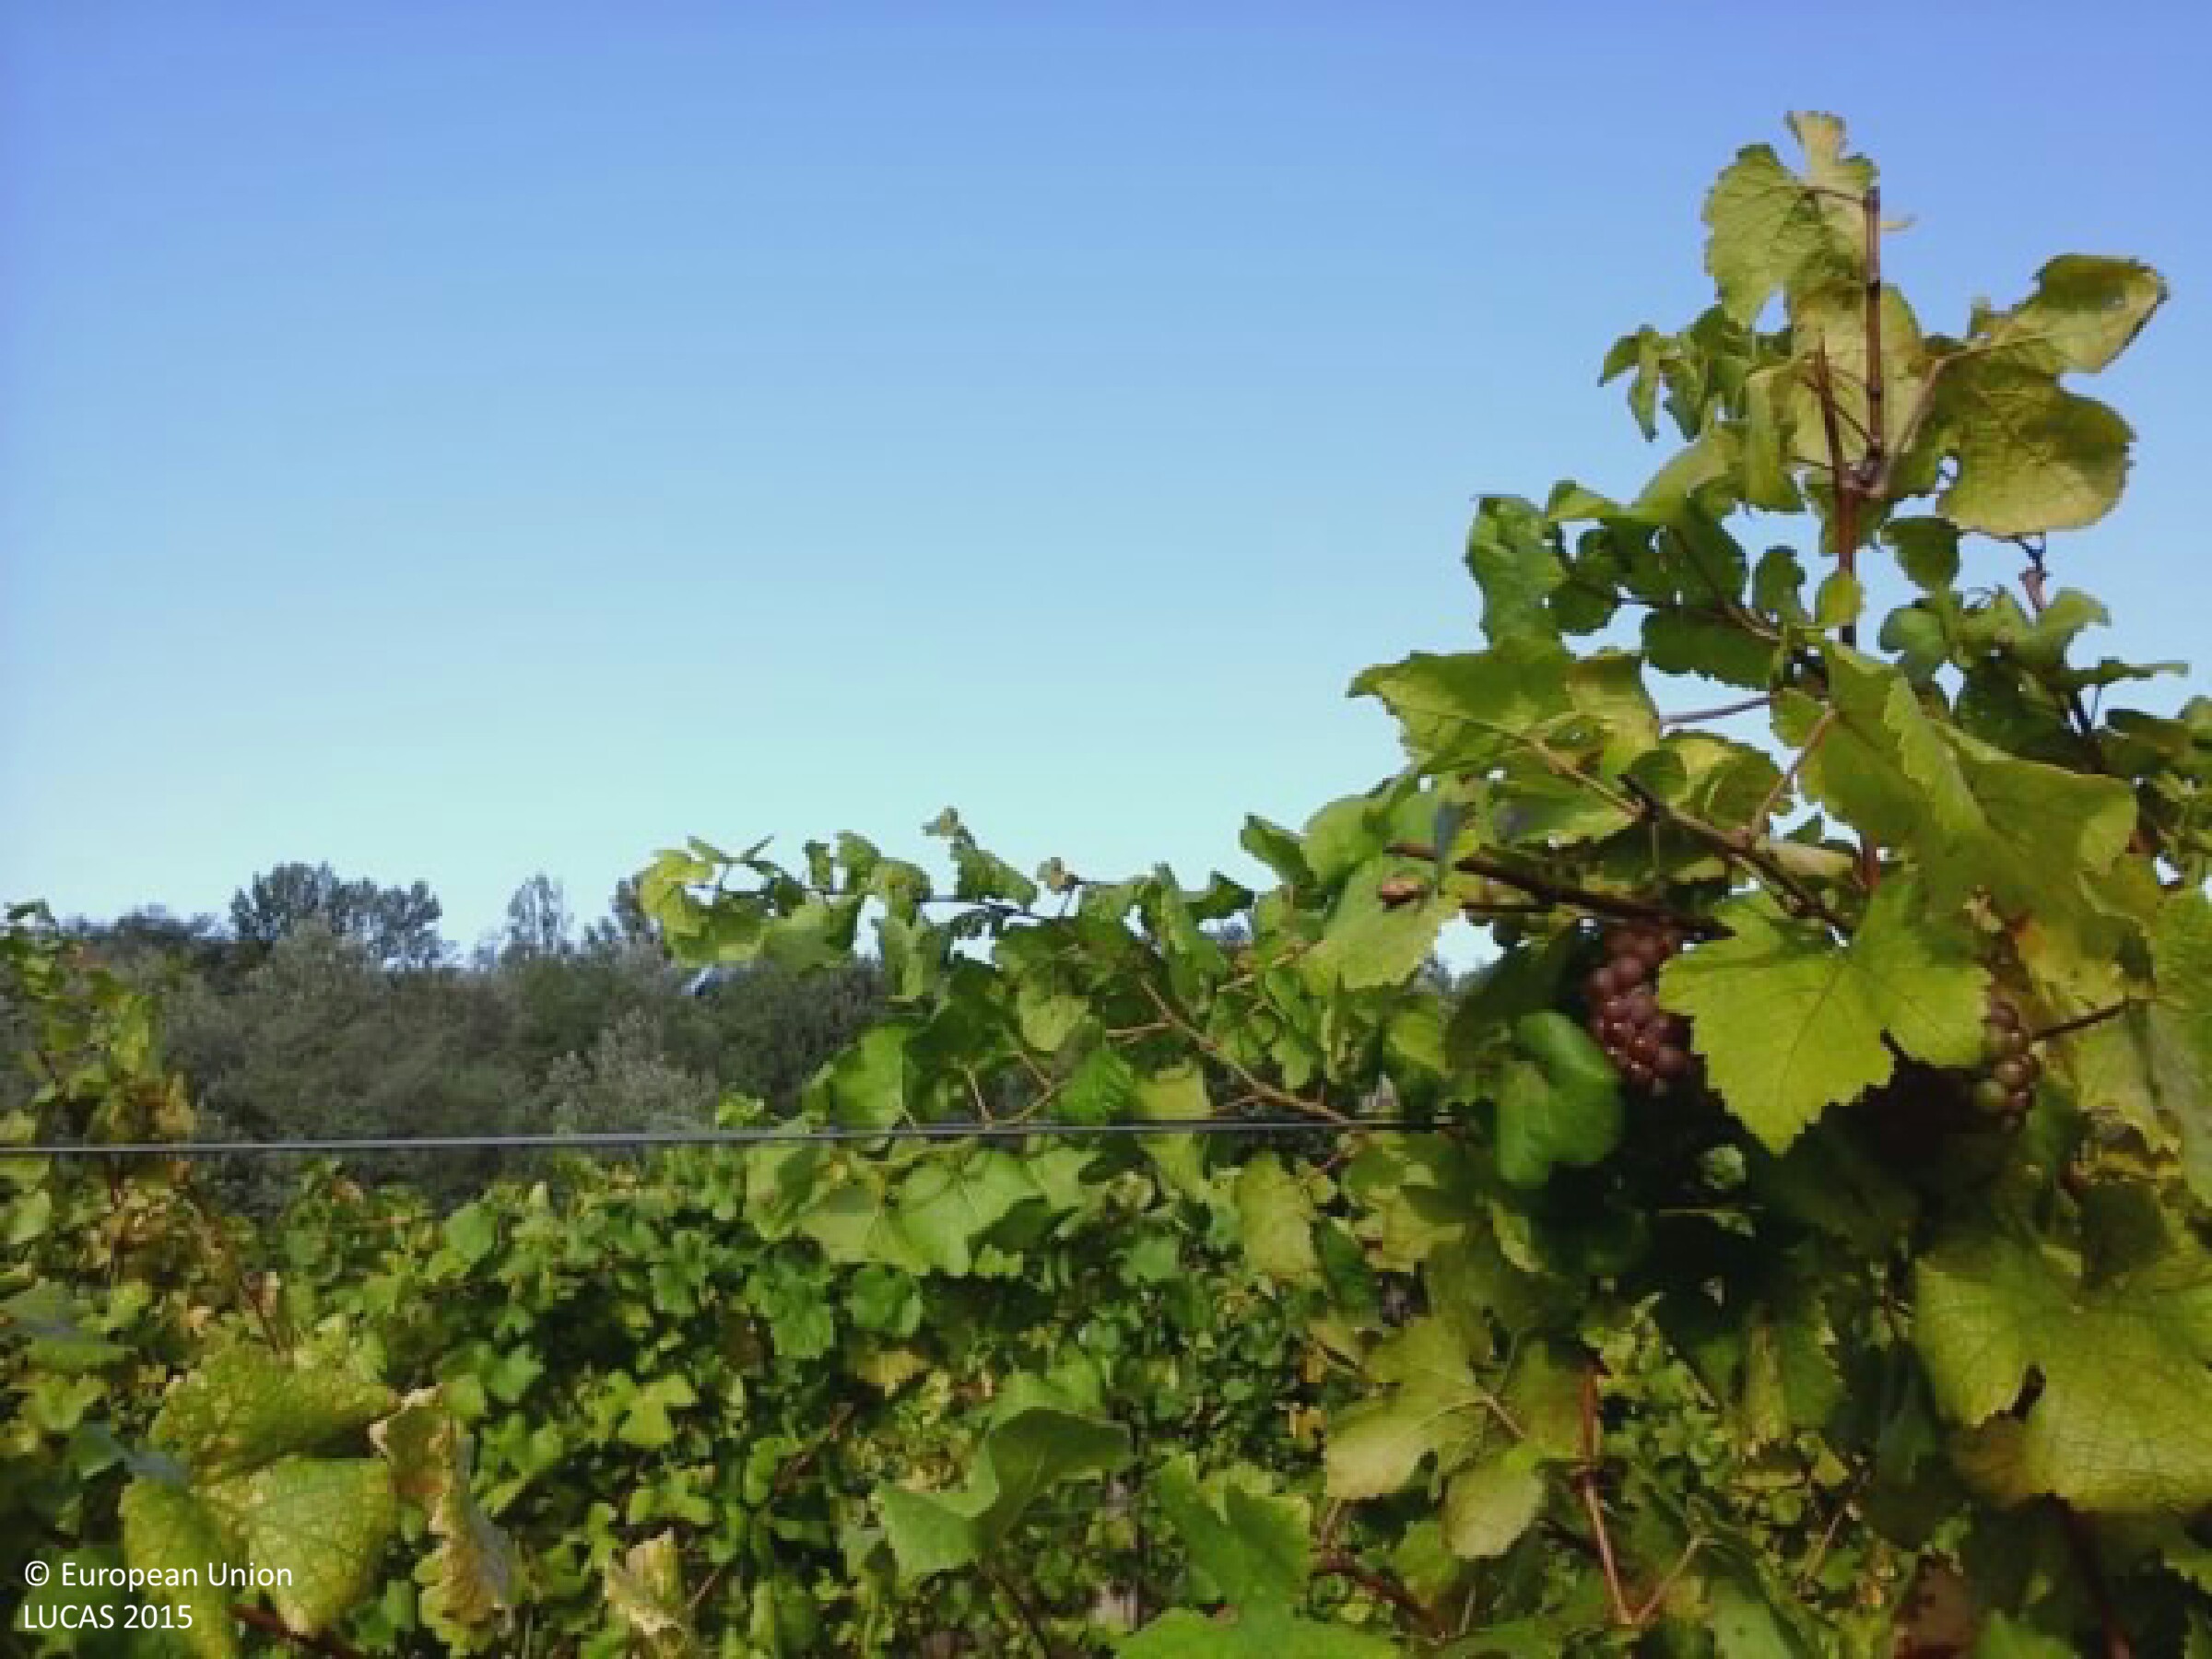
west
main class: Cropland
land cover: Vineyards
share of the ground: > 75 %
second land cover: Other bare soil
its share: > 75 %
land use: Agriculture (excluding fallow land and kitchen gardens)
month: September
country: HU
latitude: 47.7861
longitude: 19.9978
